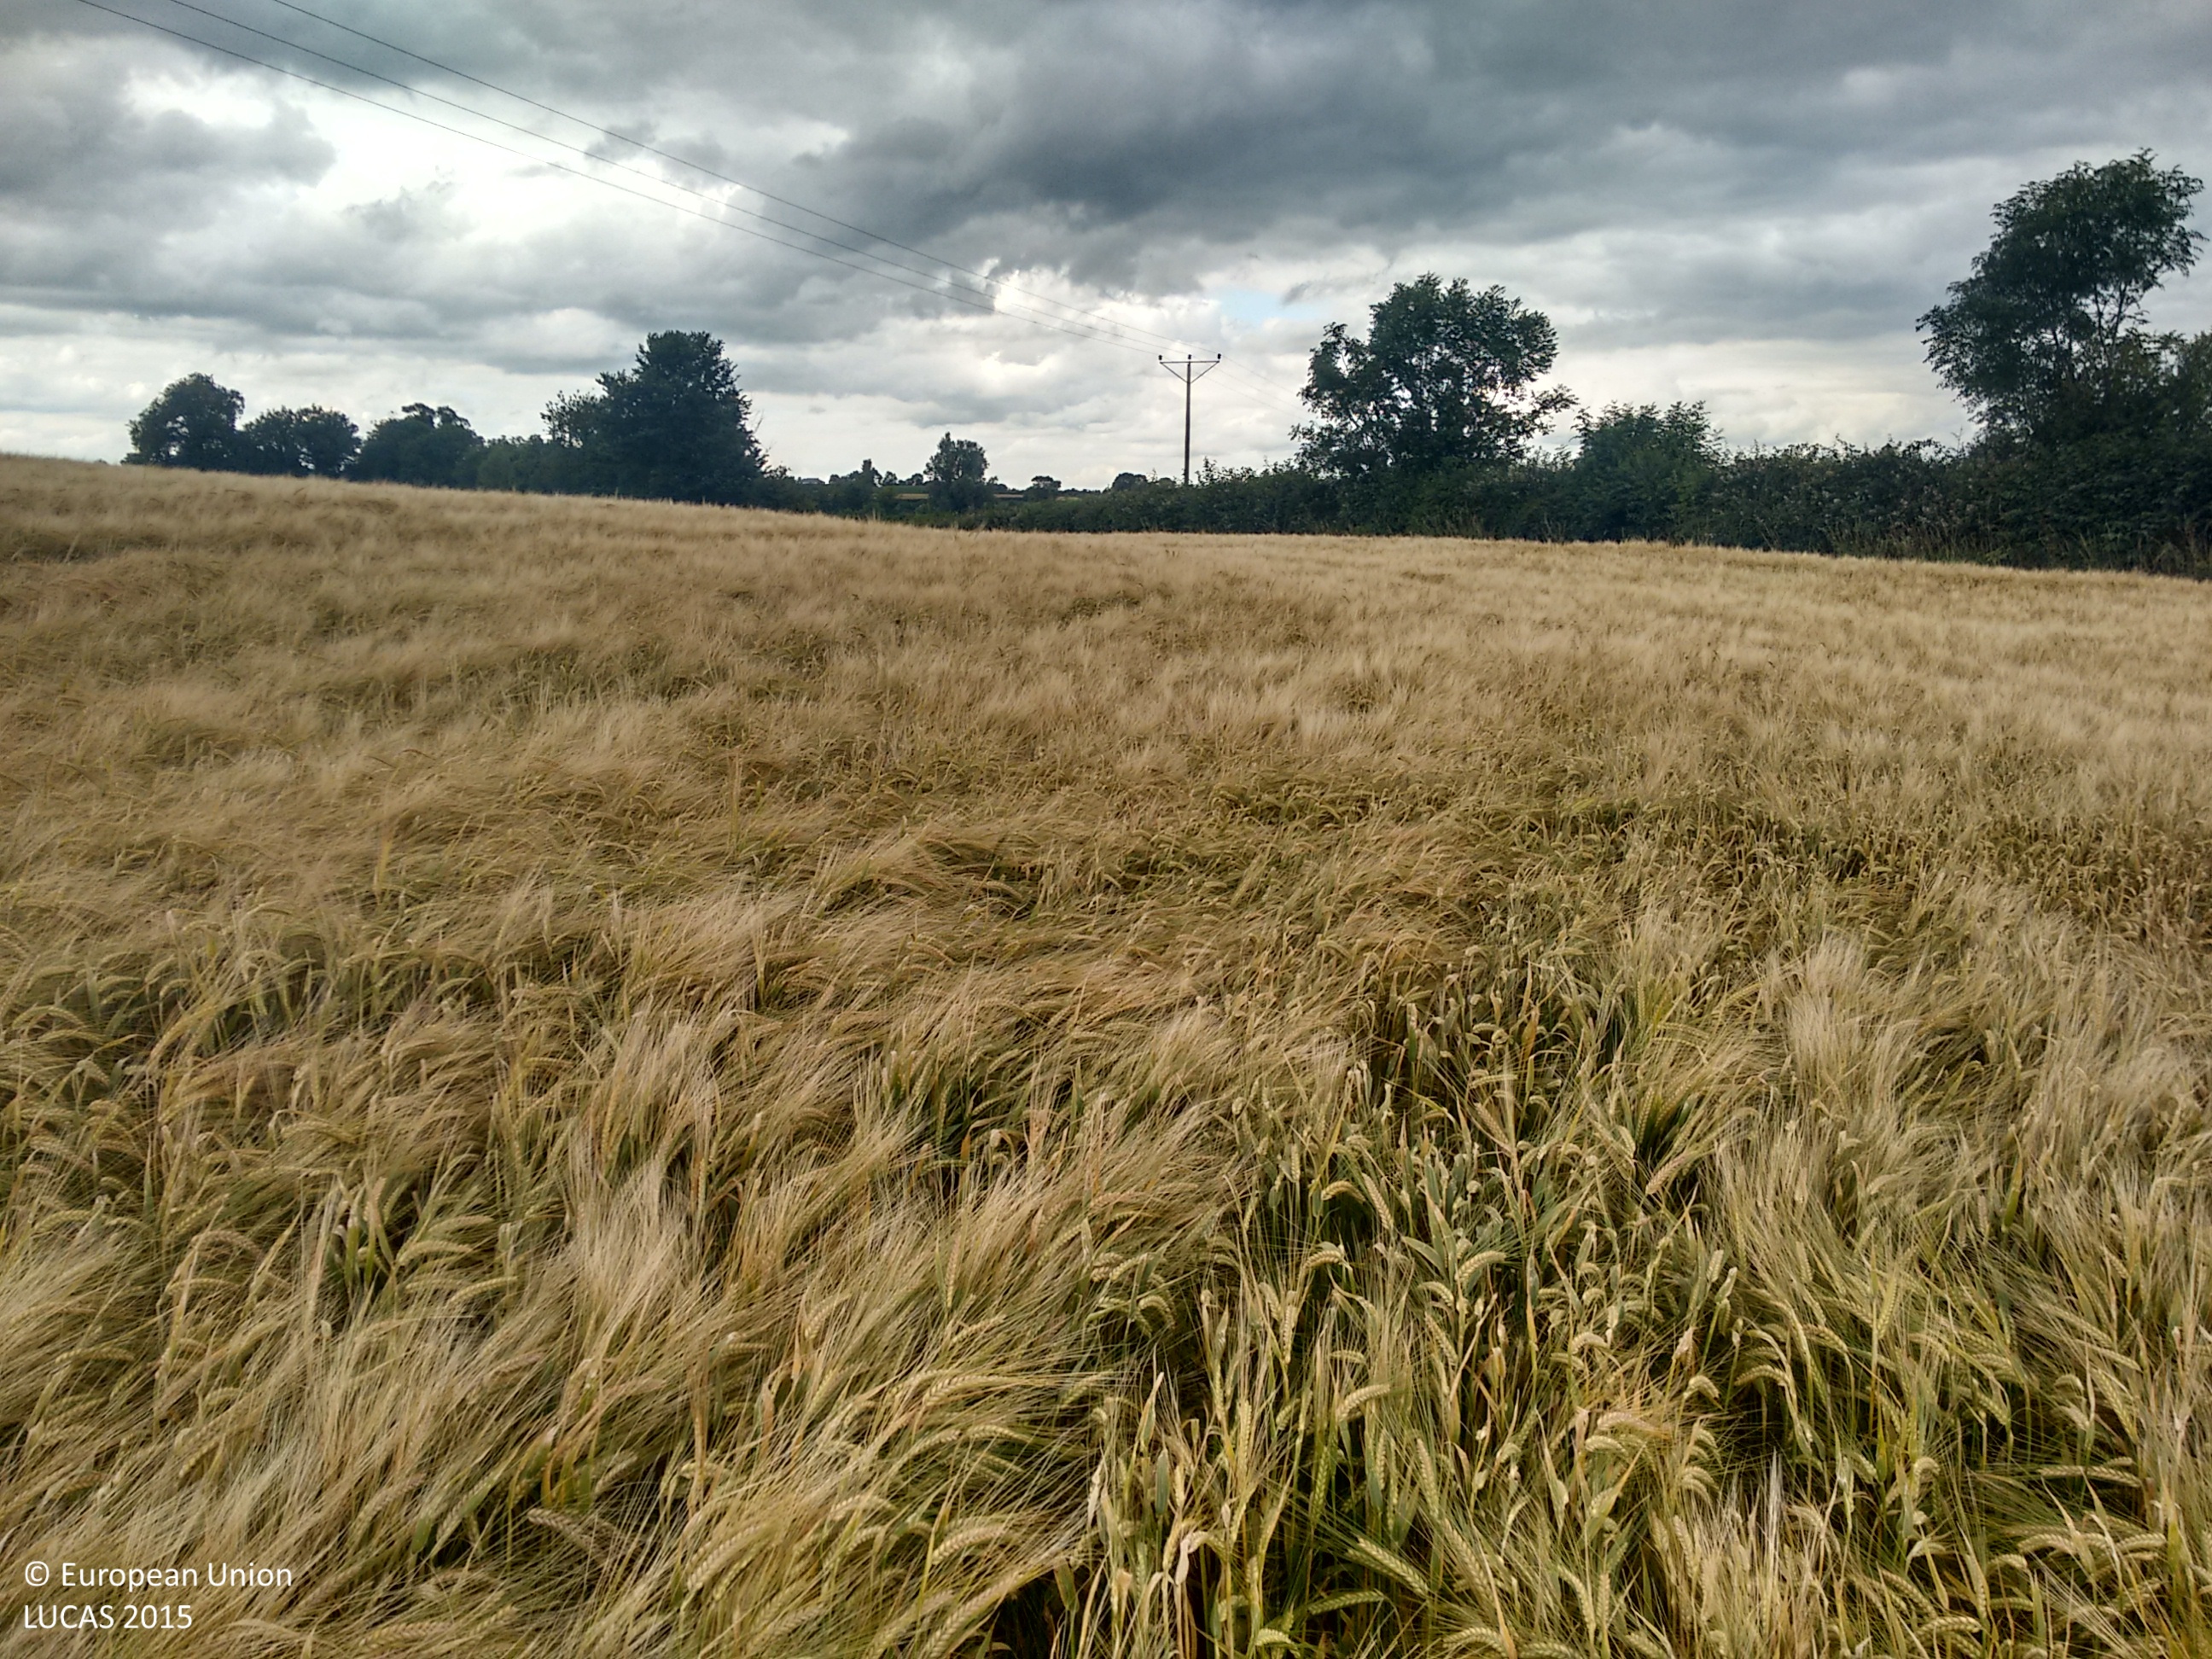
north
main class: Cropland
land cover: Barley
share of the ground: > 75 %
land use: Agriculture (excluding fallow land and kitchen gardens)
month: August
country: IE
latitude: 53.9354
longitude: -6.4688
